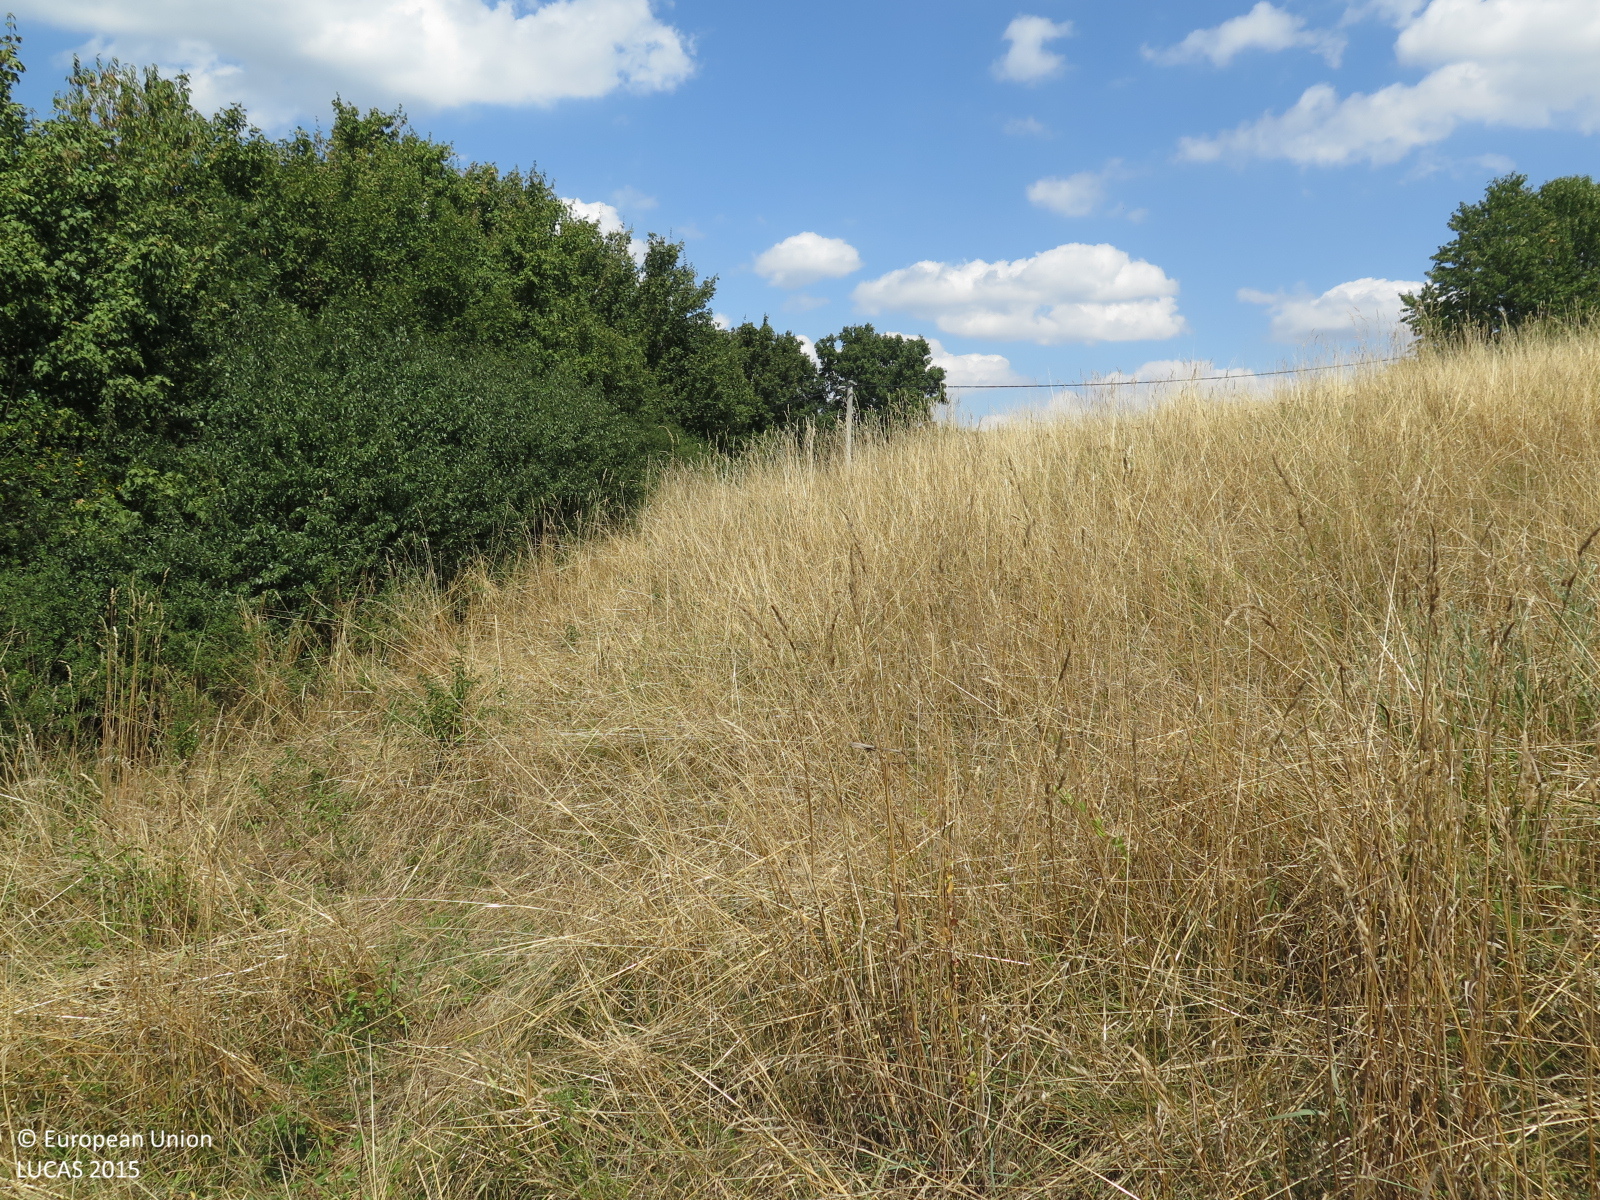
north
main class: Grassland
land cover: Grassland without tree/shrub cover
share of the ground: > 75 %
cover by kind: herbaceous plants 100 %
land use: Agriculture (excluding fallow land and kitchen gardens)
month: August
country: CZ
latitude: 50.0117
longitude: 13.8382
